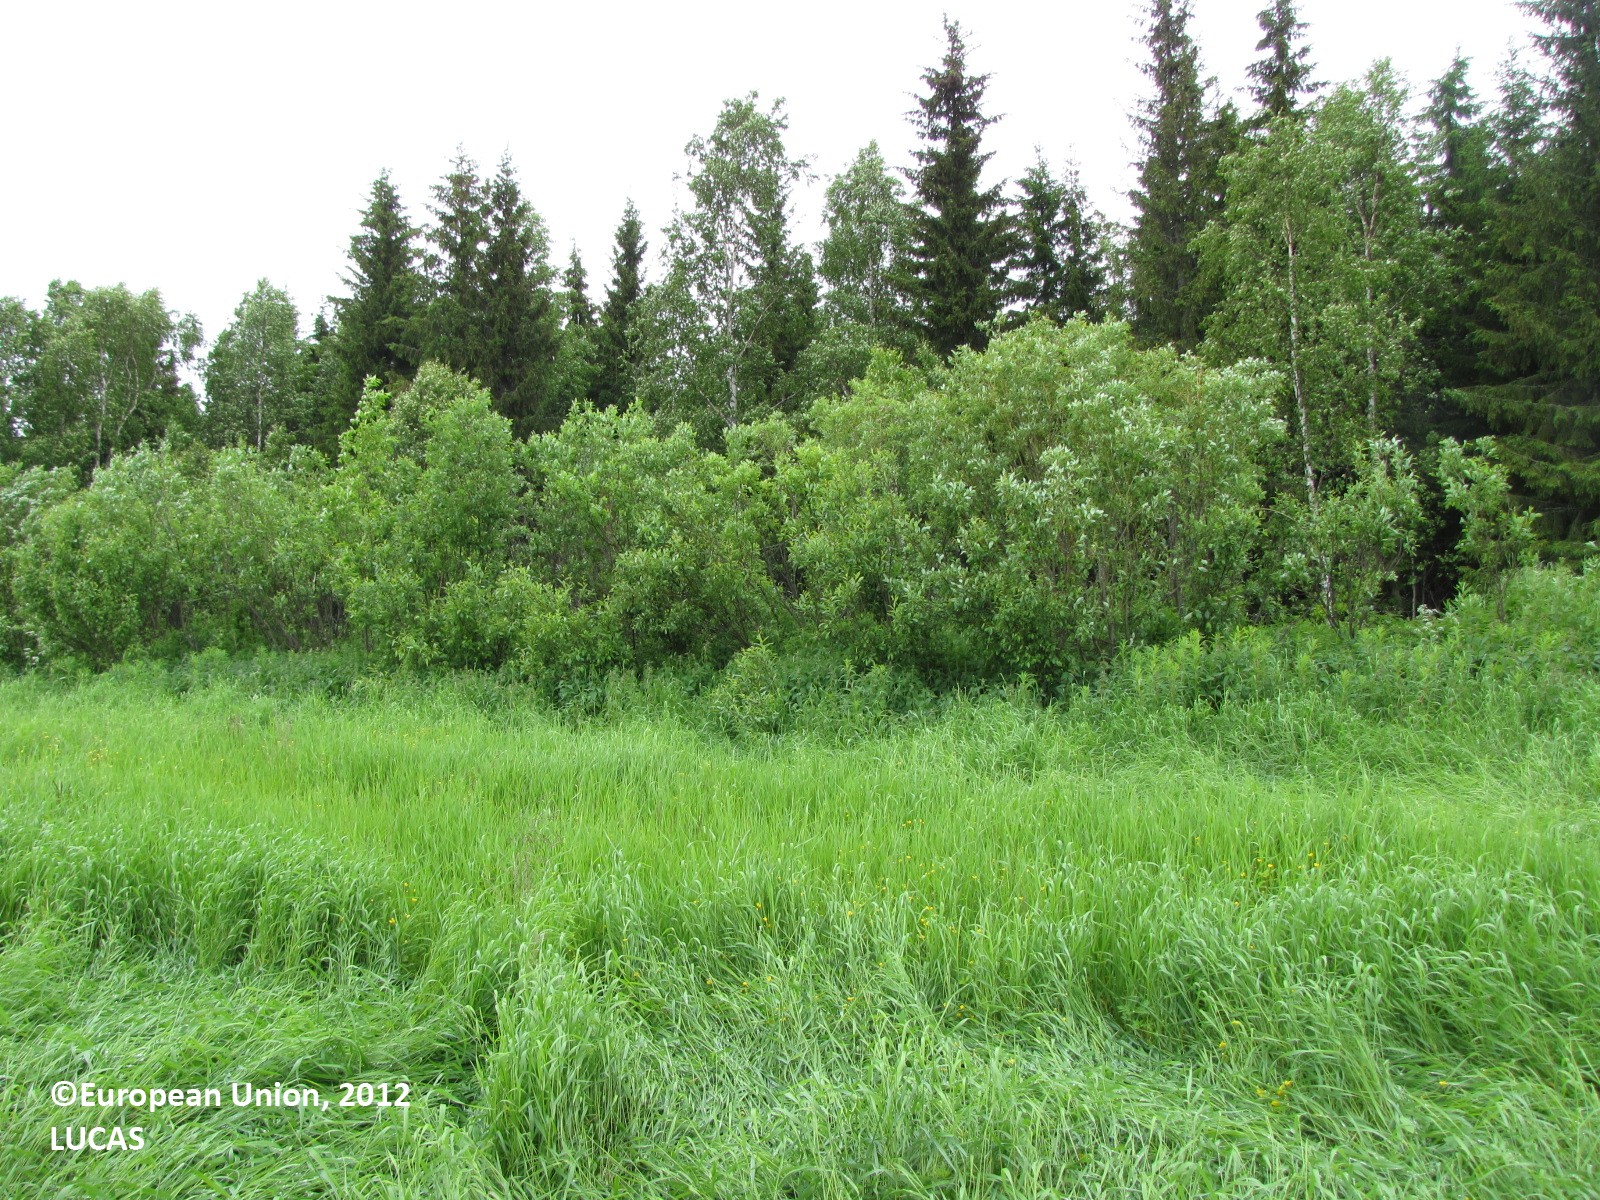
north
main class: Grassland
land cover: Grassland without tree/shrub cover
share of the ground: > 75 %
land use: Agriculture (excluding fallow land and kitchen gardens)
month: July
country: FI
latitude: 66.1077
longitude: 24.4984
